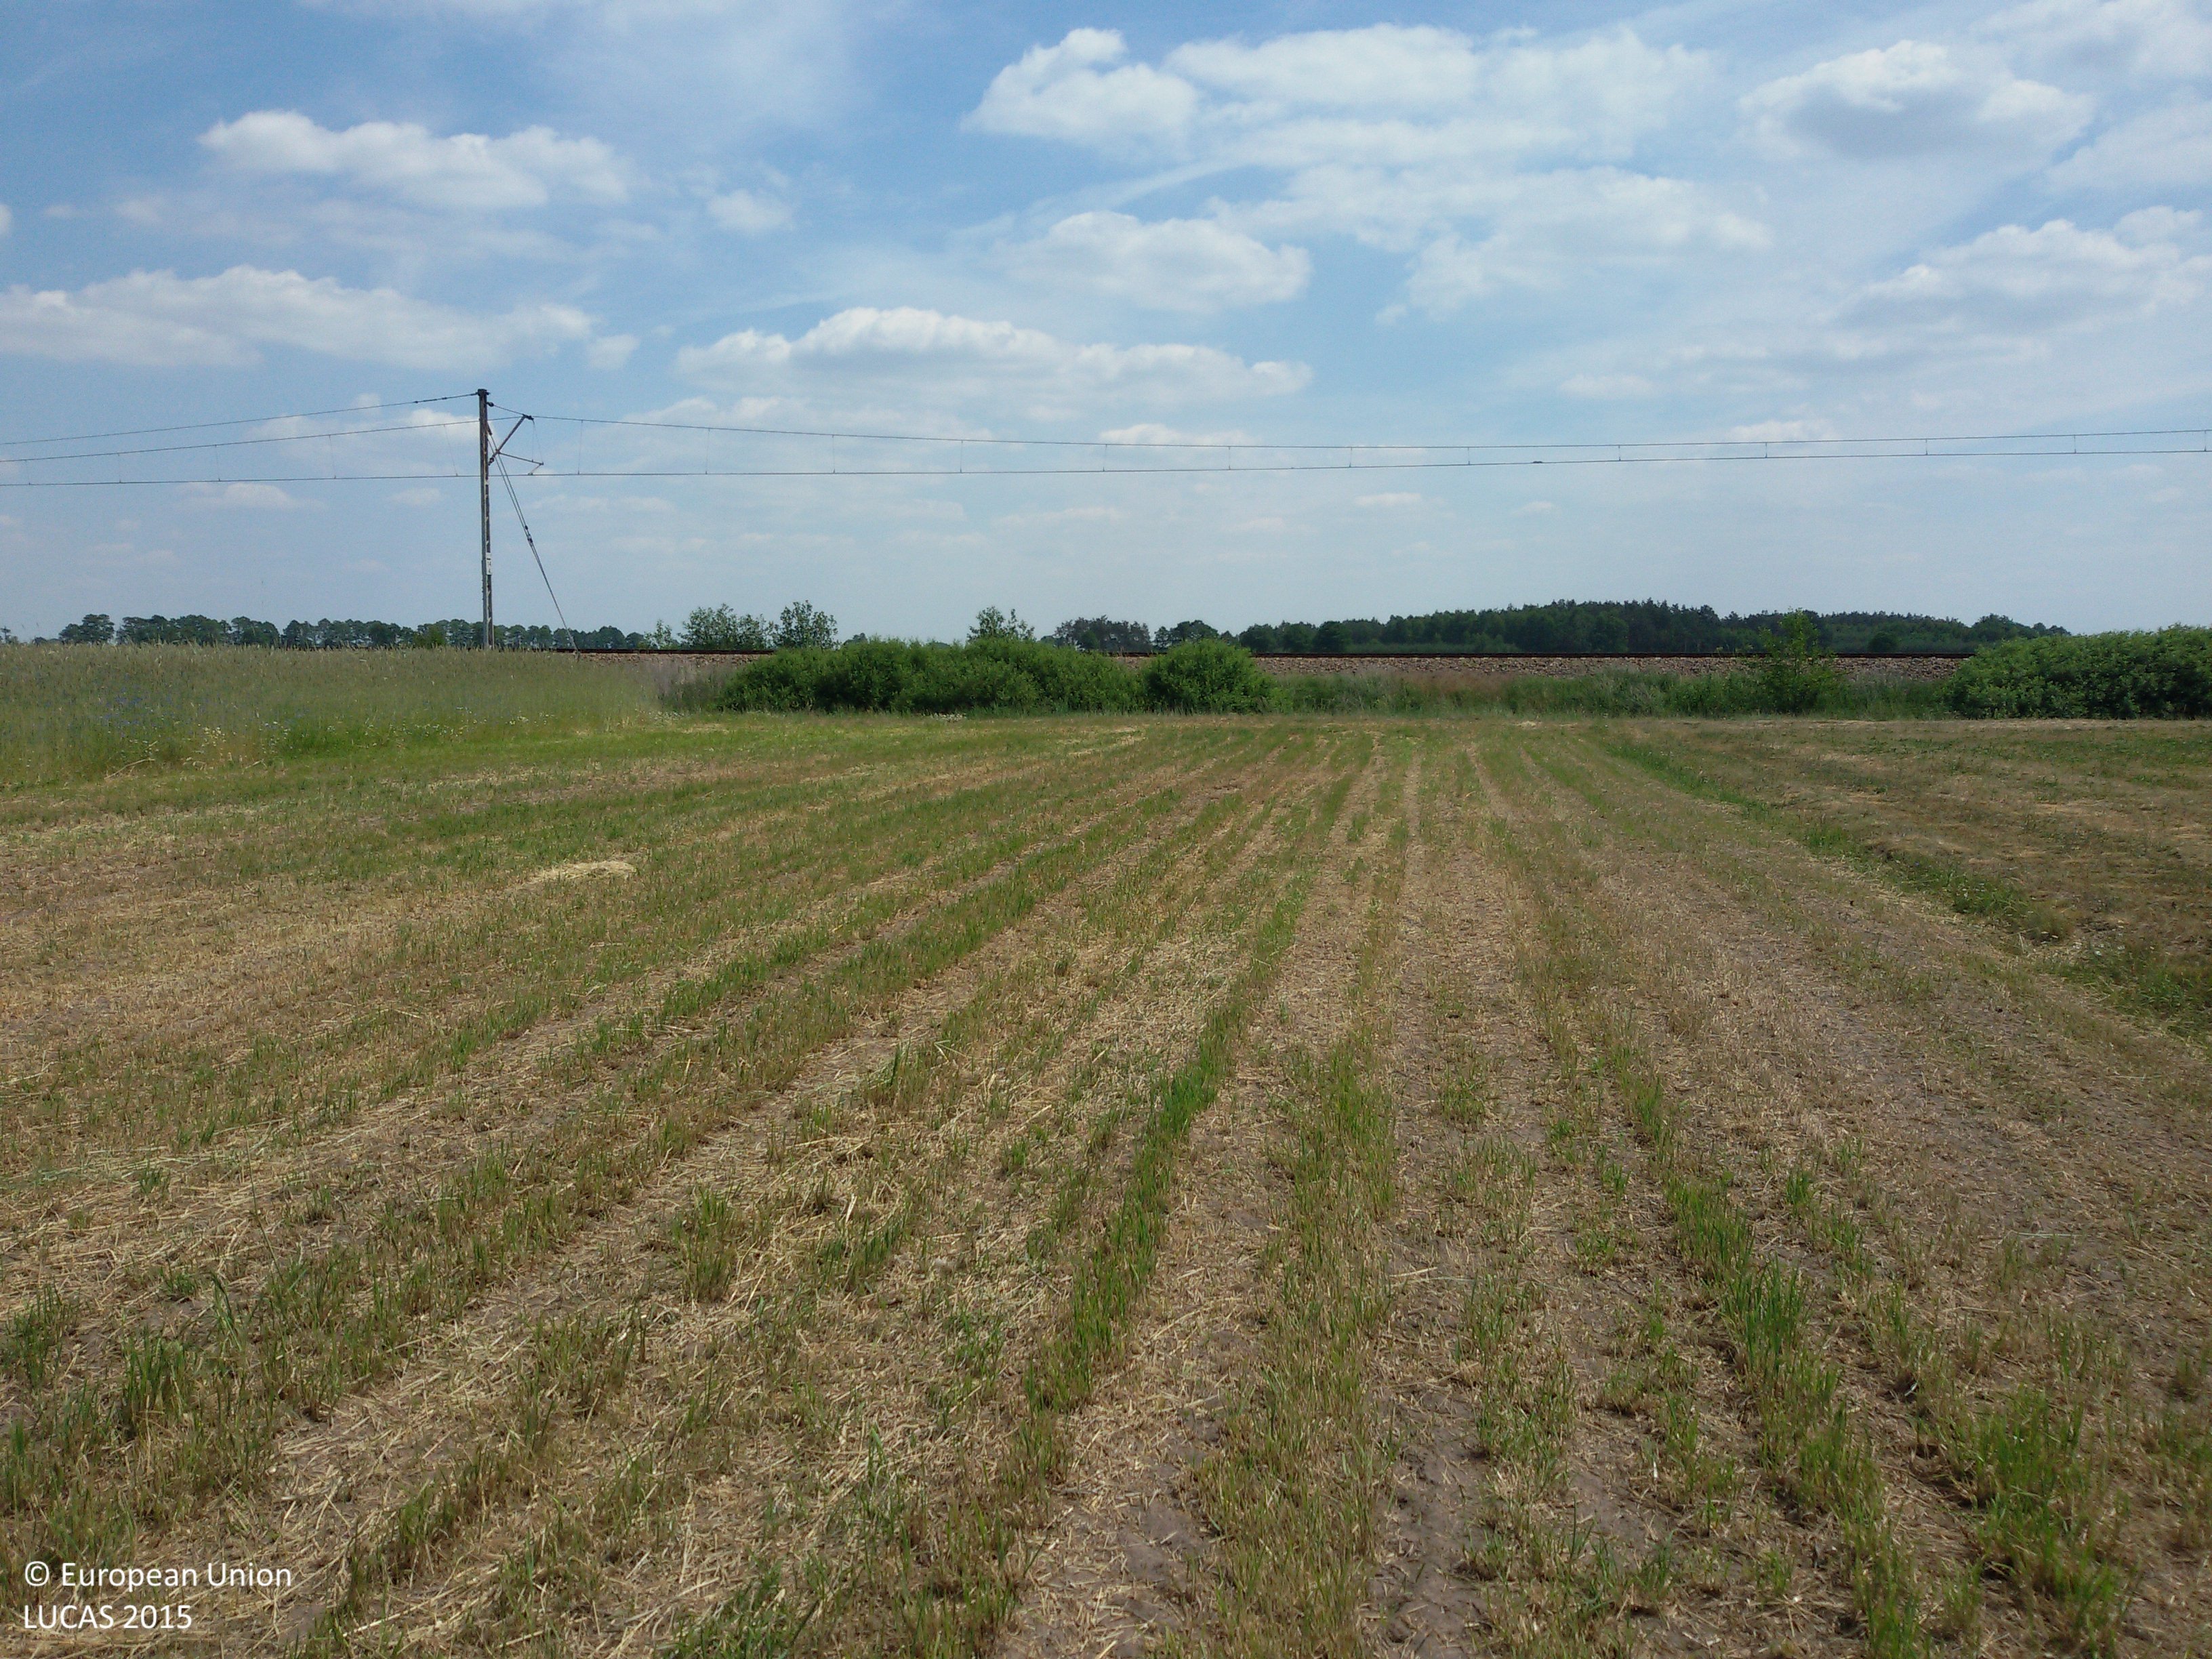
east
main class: Grassland
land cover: Grassland without tree/shrub cover
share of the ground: 50 - 75 %
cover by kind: herbaceous plants 100 %
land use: Agriculture (excluding fallow land and kitchen gardens)
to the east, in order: Grassland without tree/shrub cover; Rye; Tracks; Shrubland without tree cover; Electric lines; Railways; Grassland with sparse tree/shrub cover; Tracks; Grass margins; Rye; Grass margins; Oats; Rye
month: June
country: PL
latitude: 52.0529
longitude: 19.9045
